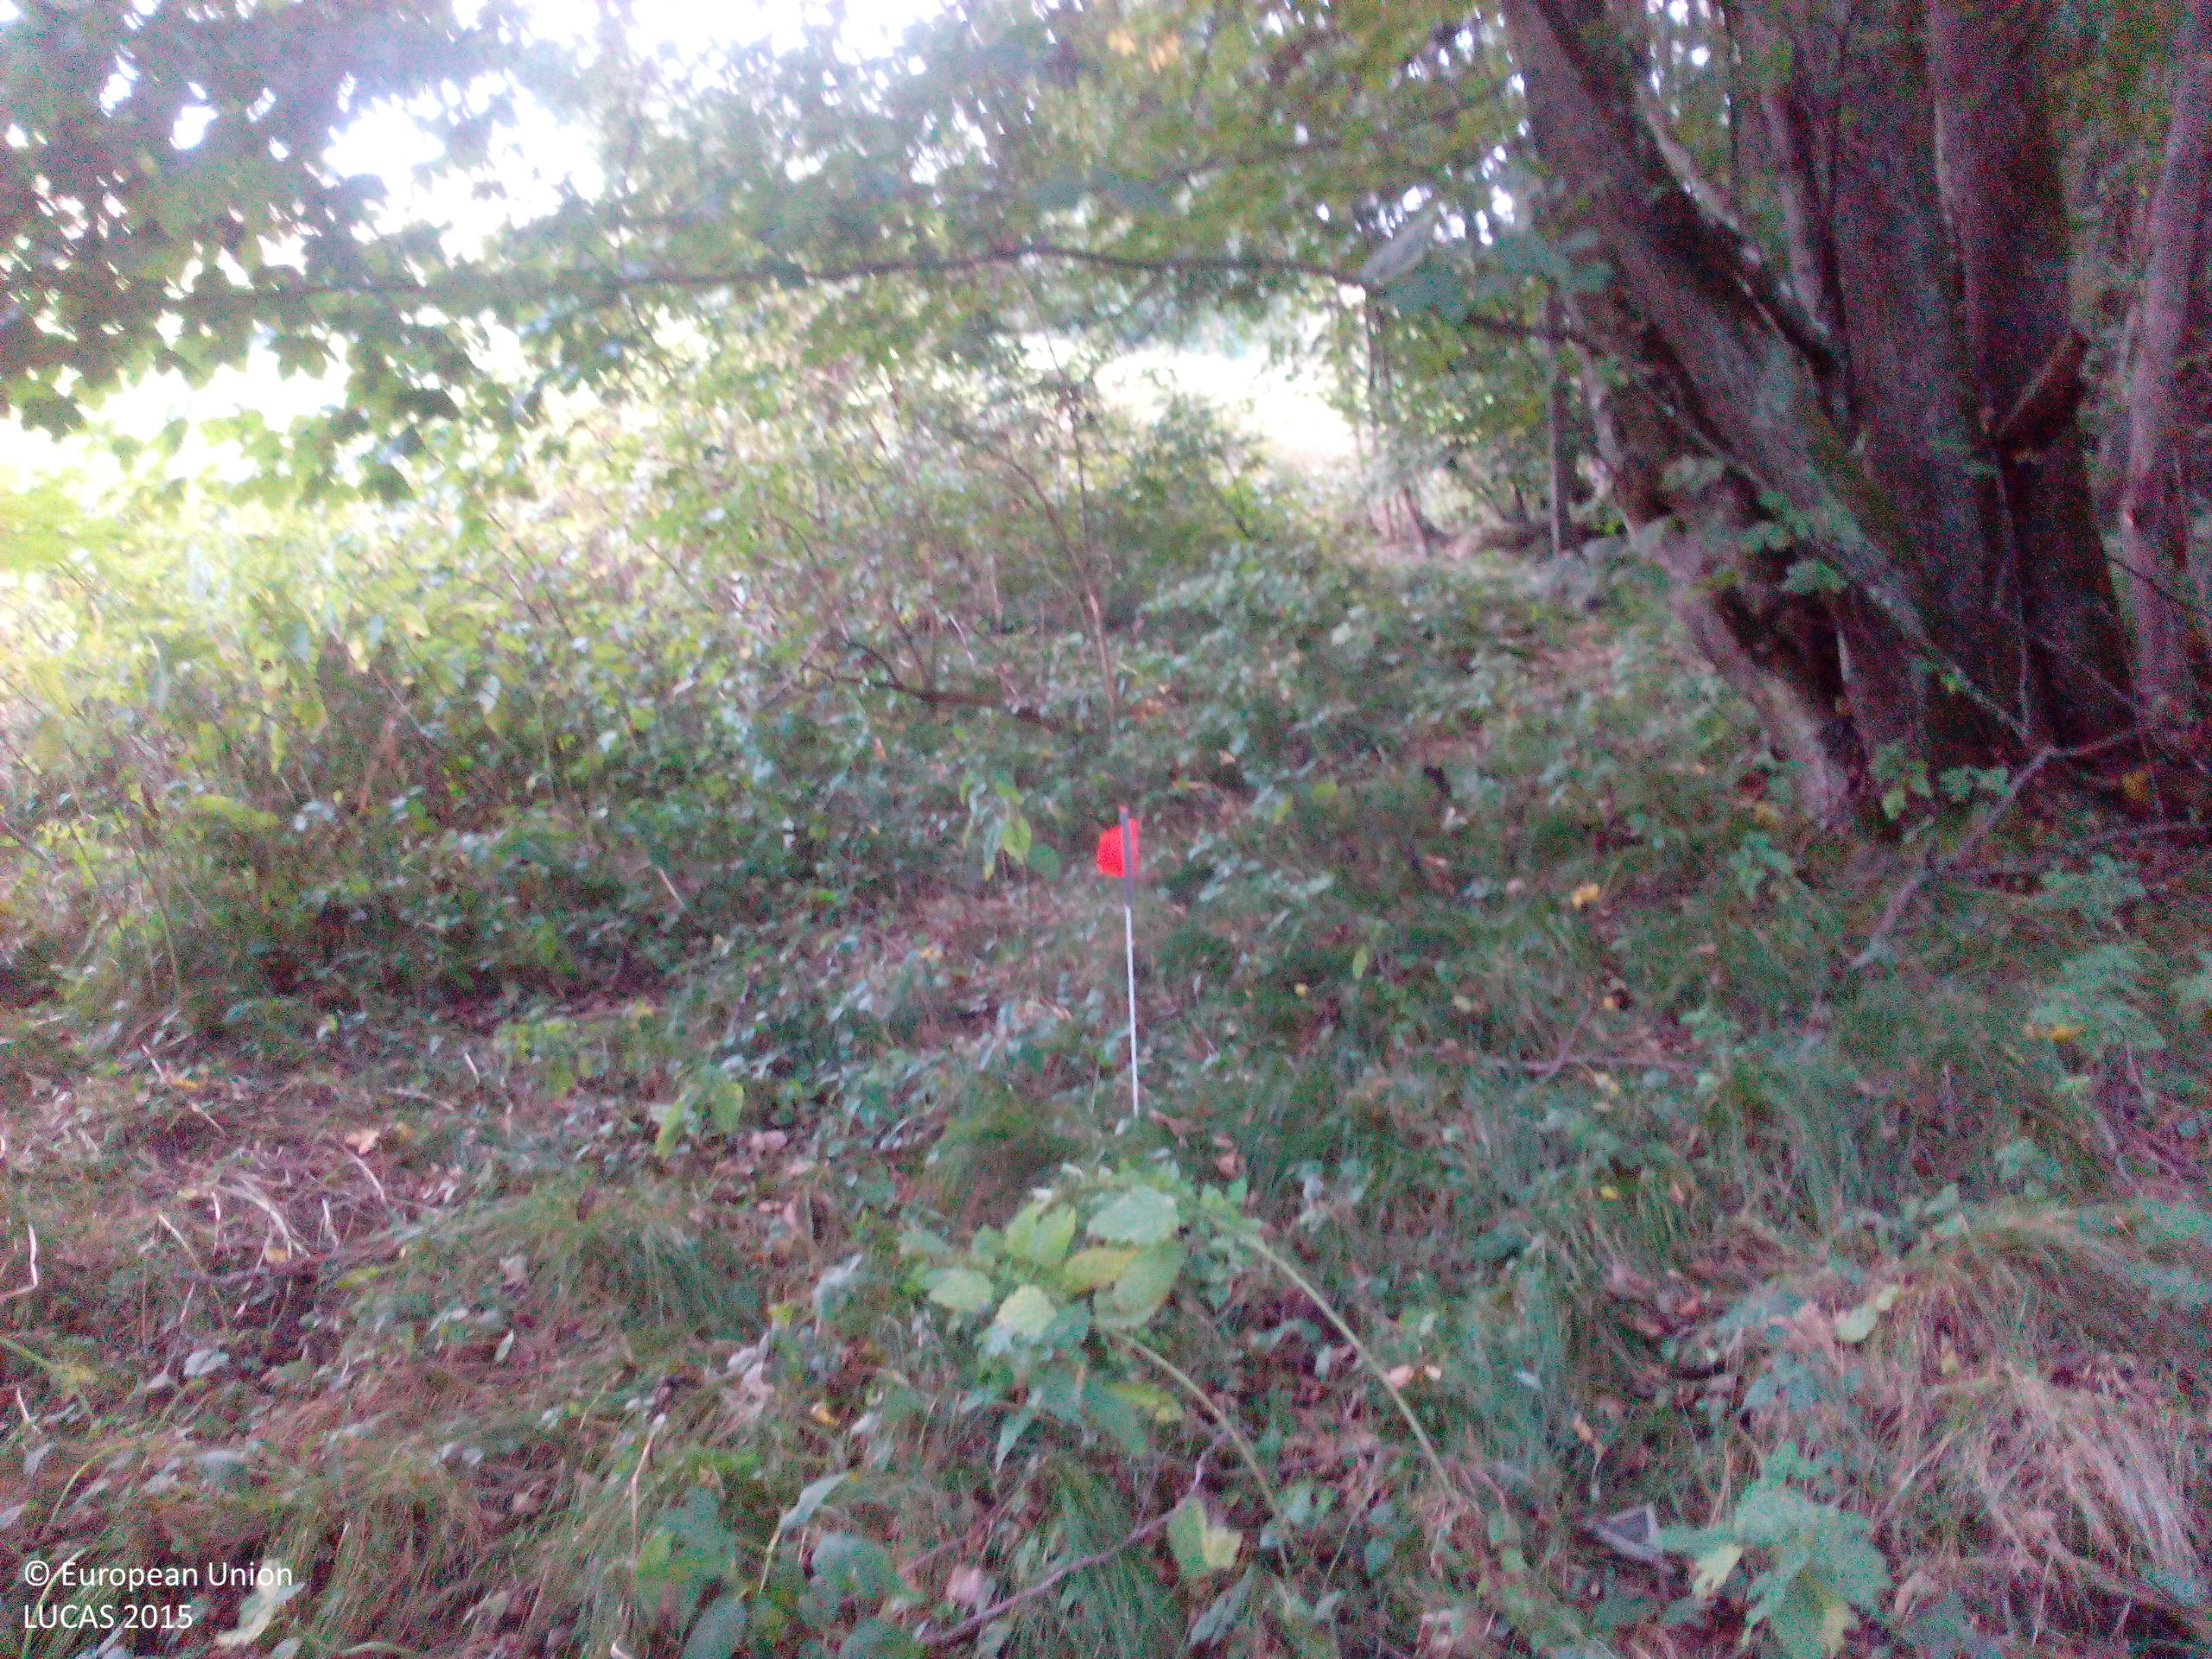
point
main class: Woodland
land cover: Broadleaved woodland
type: mesophytic deciduous forest
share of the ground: > 75 %
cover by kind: broadleaved forest trees 100 %
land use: Semi-natural and natural areas not in use
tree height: > 5 m
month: September
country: DE
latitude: 48.9939
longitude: 12.9653
